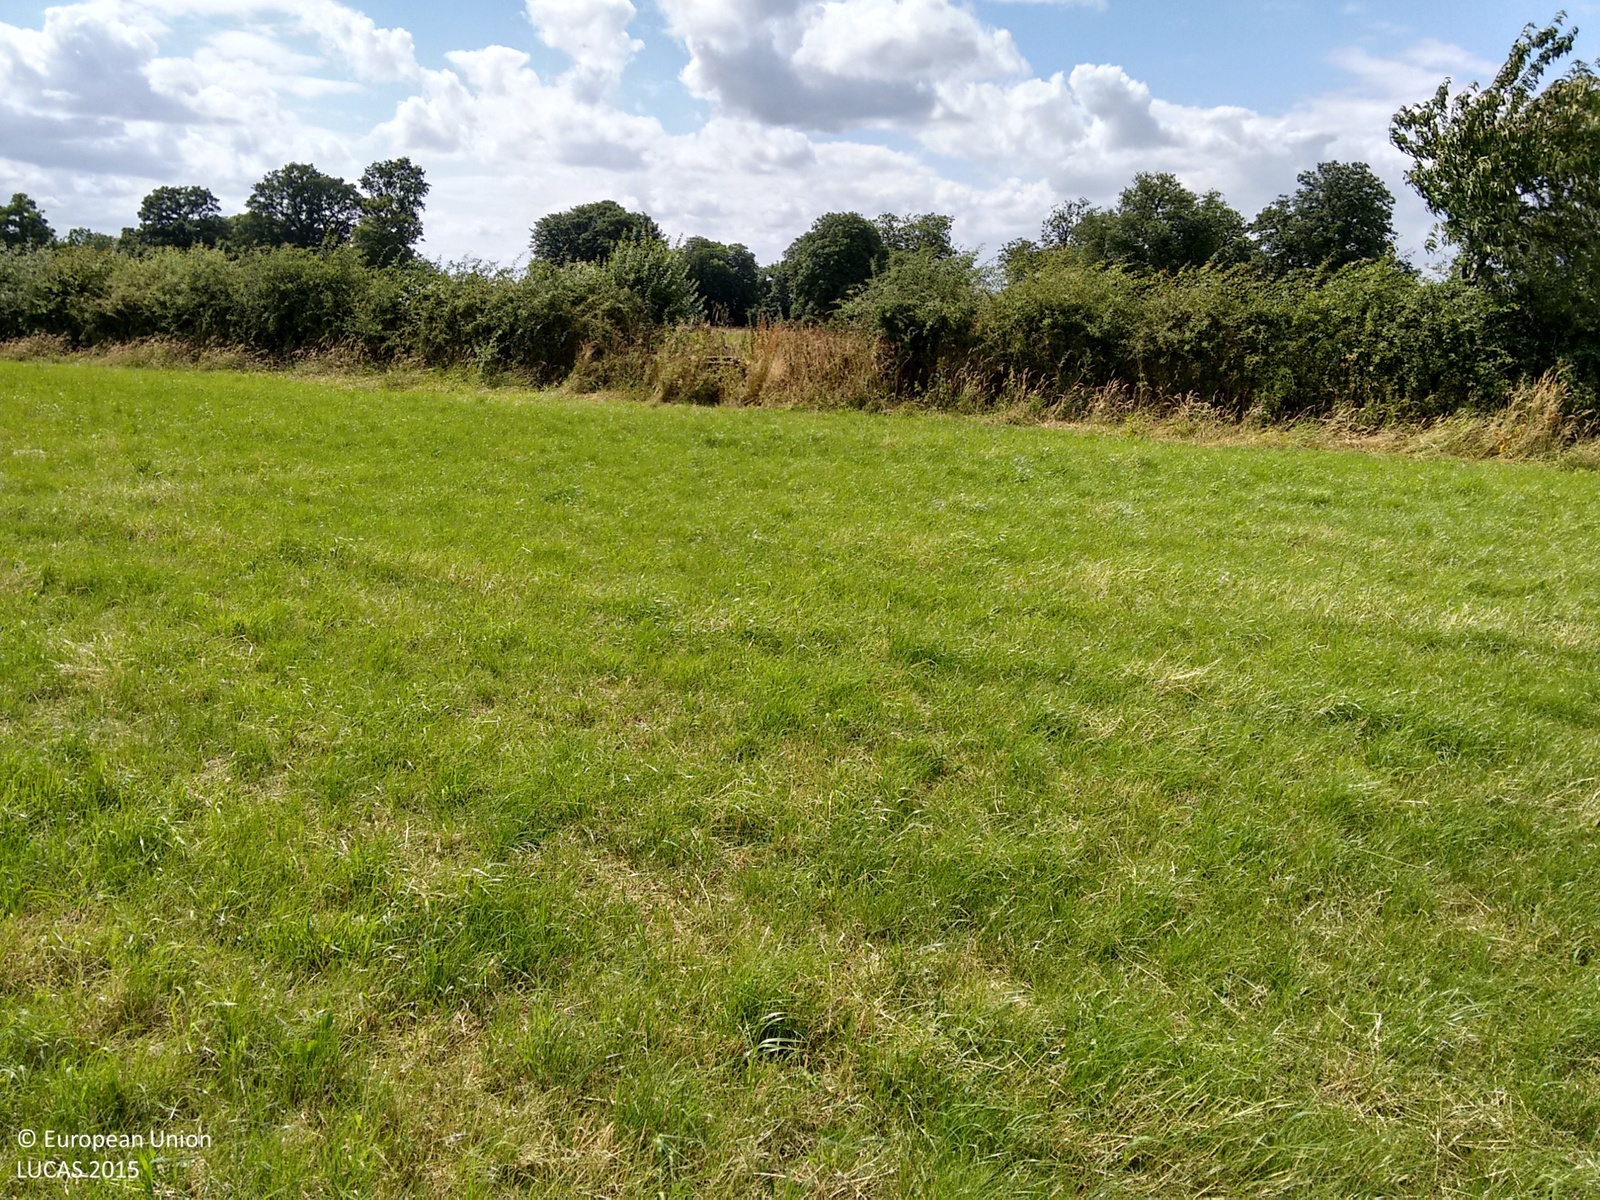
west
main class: Grassland
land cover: Grassland without tree/shrub cover
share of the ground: > 75 %
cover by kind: herbaceous plants 100 %
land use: Agriculture (excluding fallow land and kitchen gardens)
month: July
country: GB
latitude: 52.6658
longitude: -0.9710
